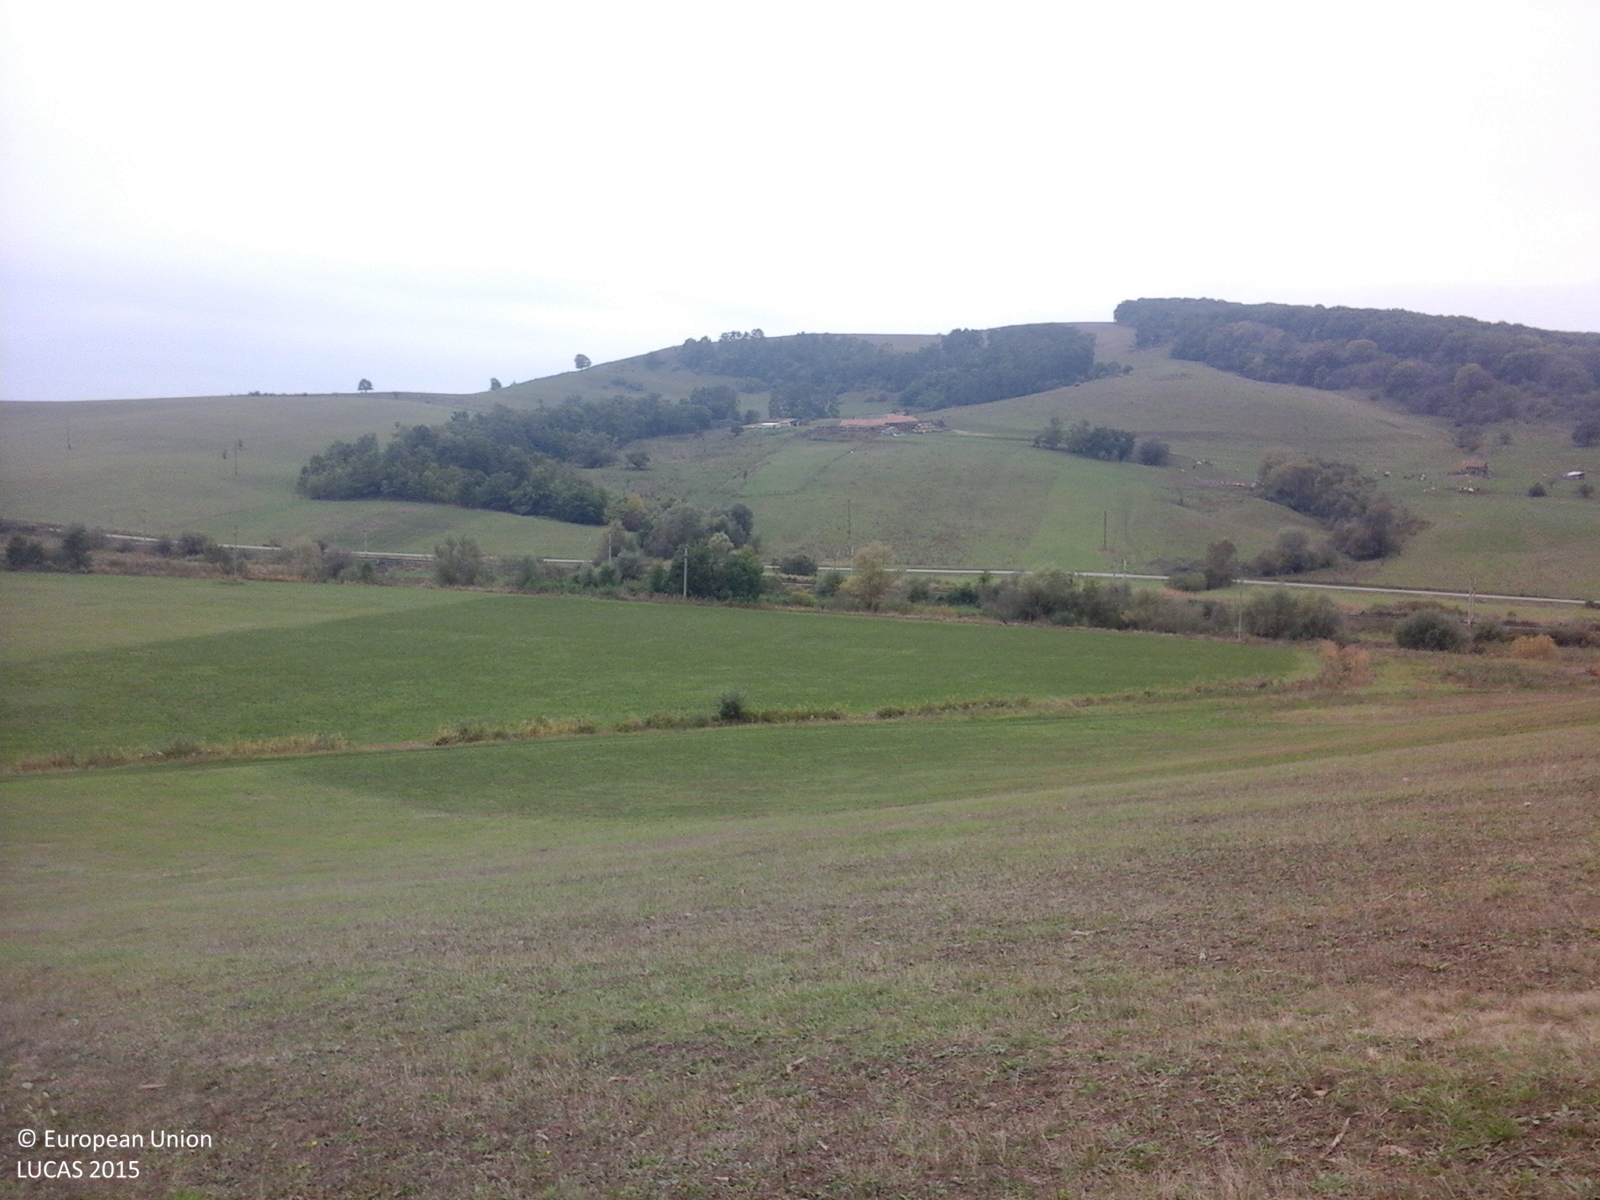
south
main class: Grassland
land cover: Grassland without tree/shrub cover
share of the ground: > 75 %
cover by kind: herbaceous plants 100 %
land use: Agriculture (excluding fallow land and kitchen gardens)
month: October
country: RO
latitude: 46.1104
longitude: 25.2507
